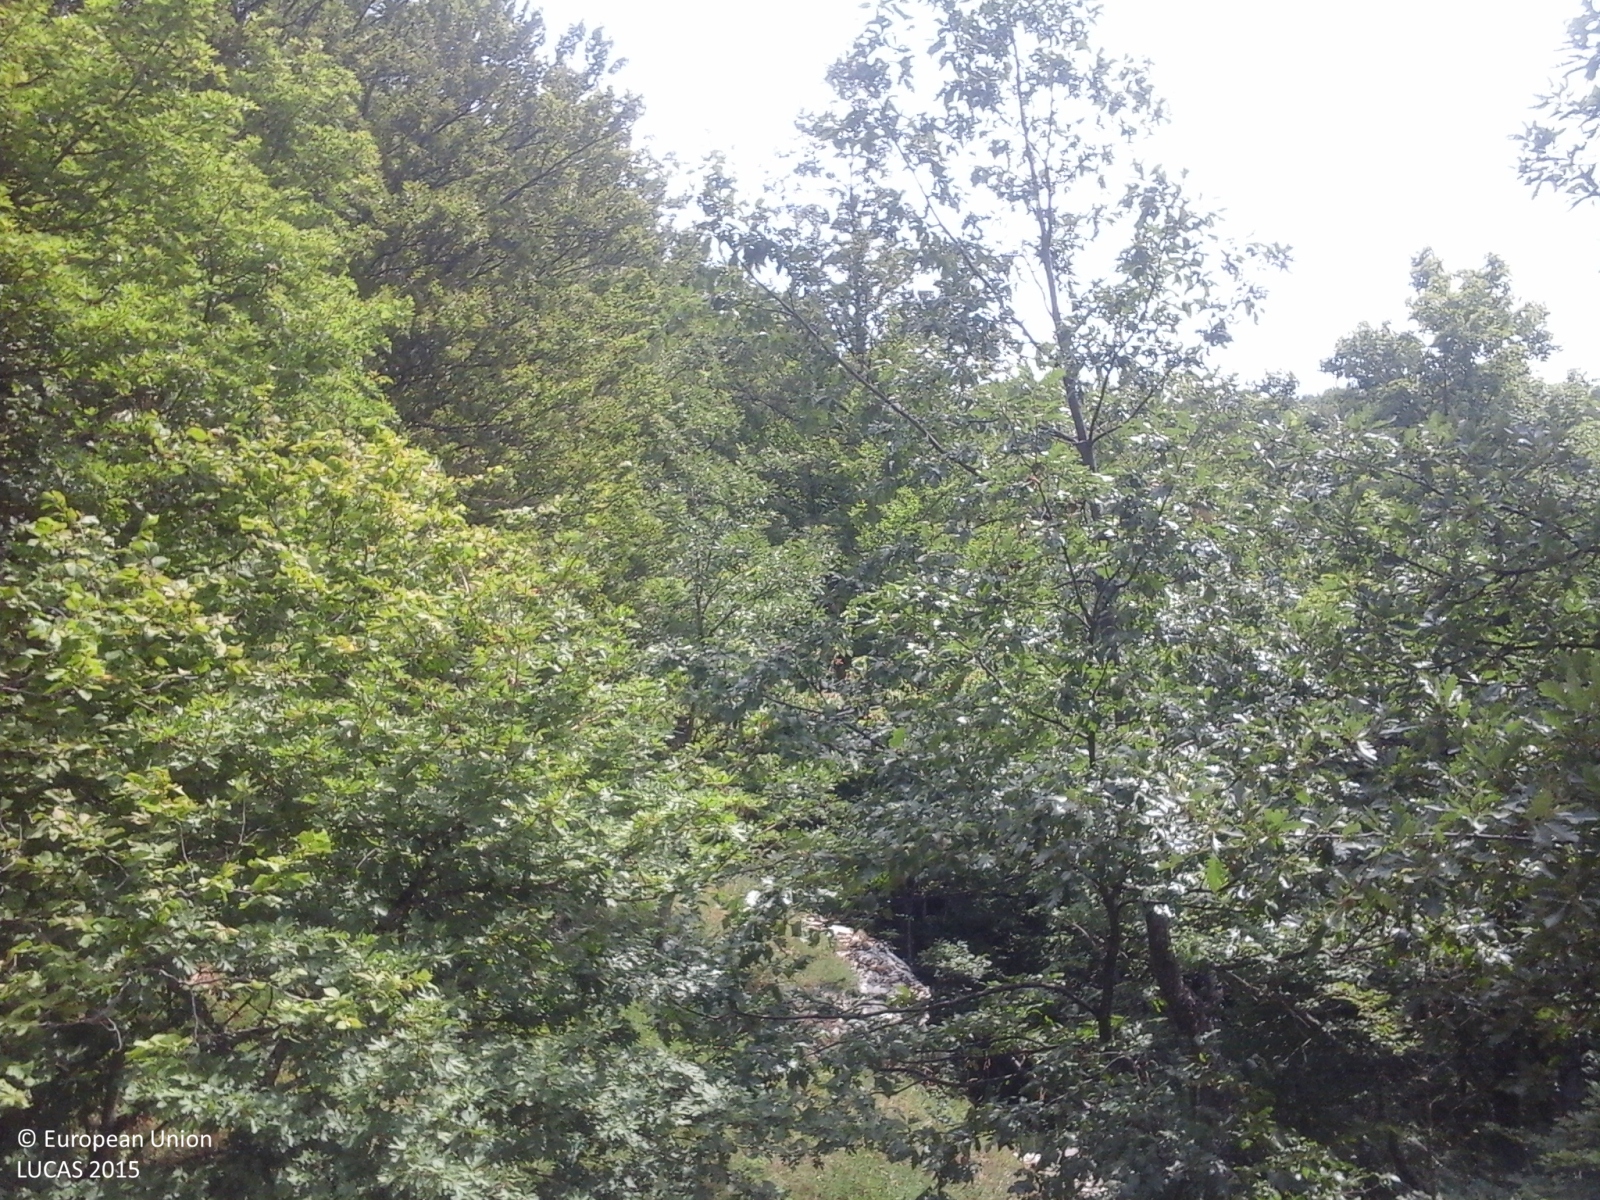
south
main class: Woodland
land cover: Broadleaved woodland
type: thermophilous deciduous forest
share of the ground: > 75 %
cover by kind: broadleaved forest trees 100 %
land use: Forestry
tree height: > 5 m
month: July
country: IT
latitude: 44.4043
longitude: 10.2881
